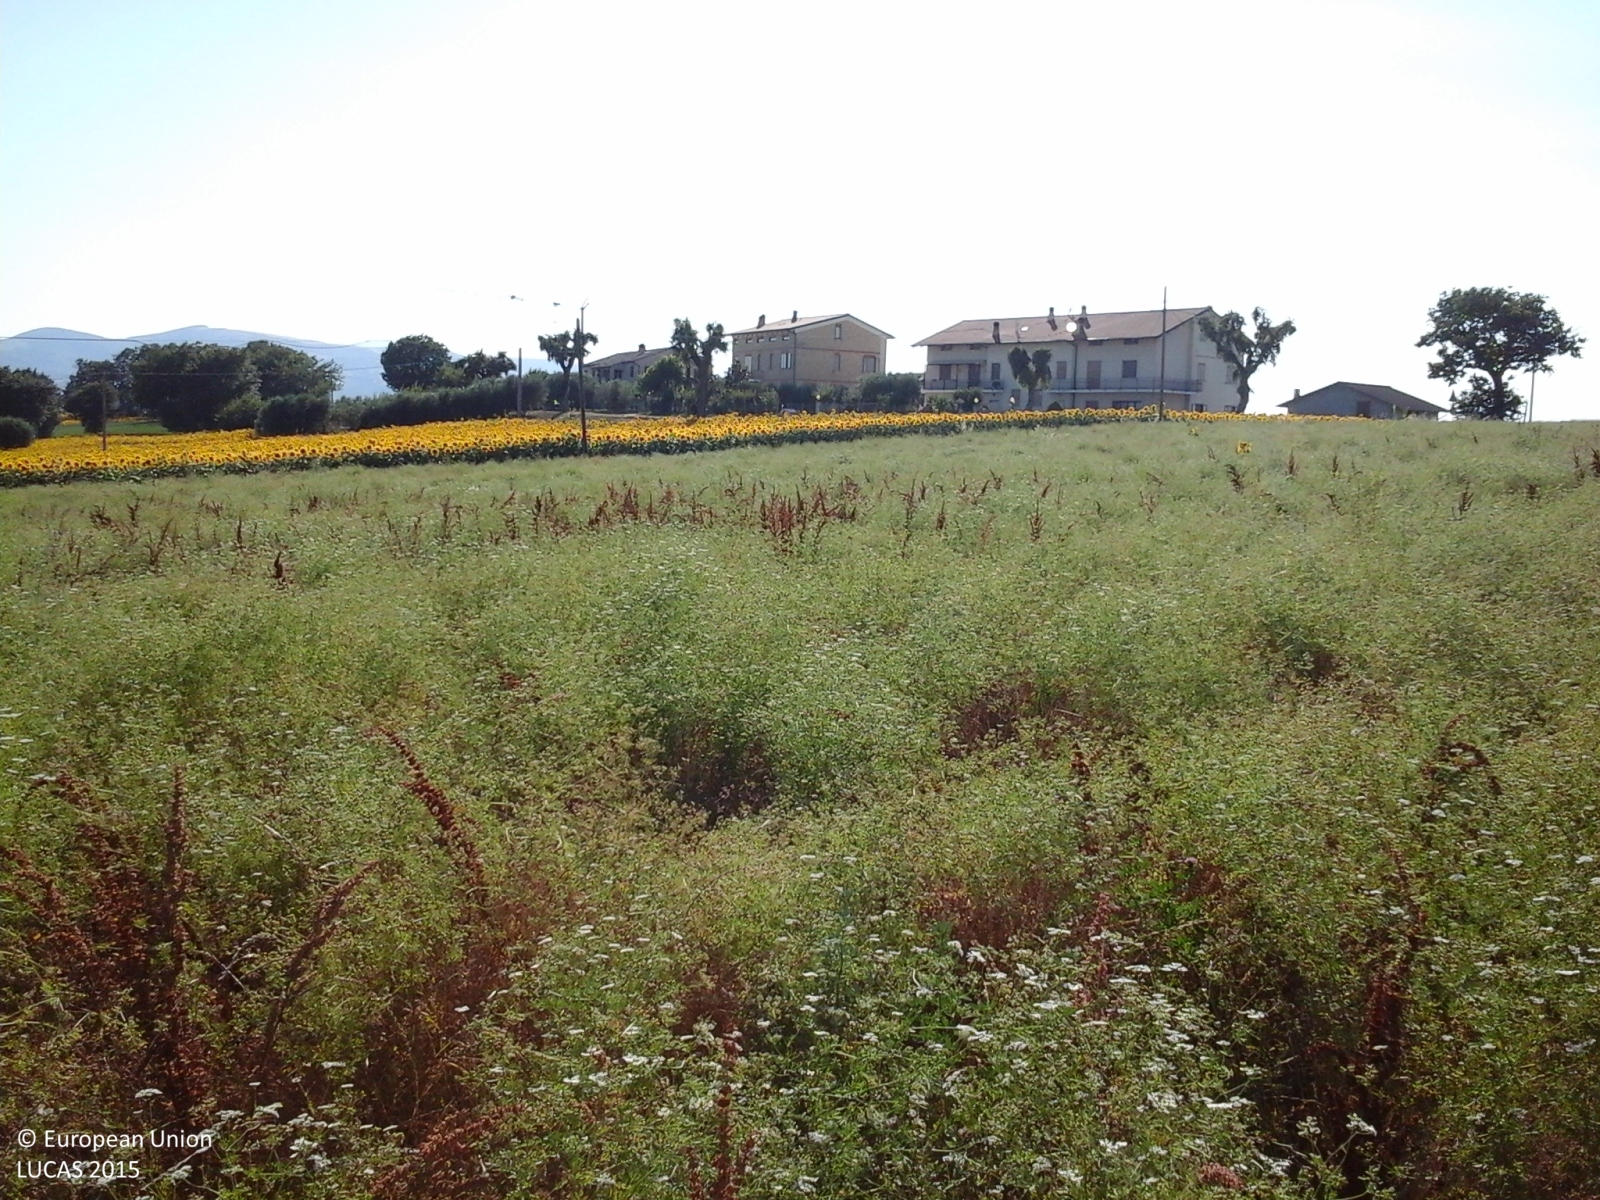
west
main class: Cropland
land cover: Other non-permanent industrial crops
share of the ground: > 75 %
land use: Agriculture (excluding fallow land and kitchen gardens)
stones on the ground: 10 - 25 %
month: July
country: IT
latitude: 43.3760
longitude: 13.3363
